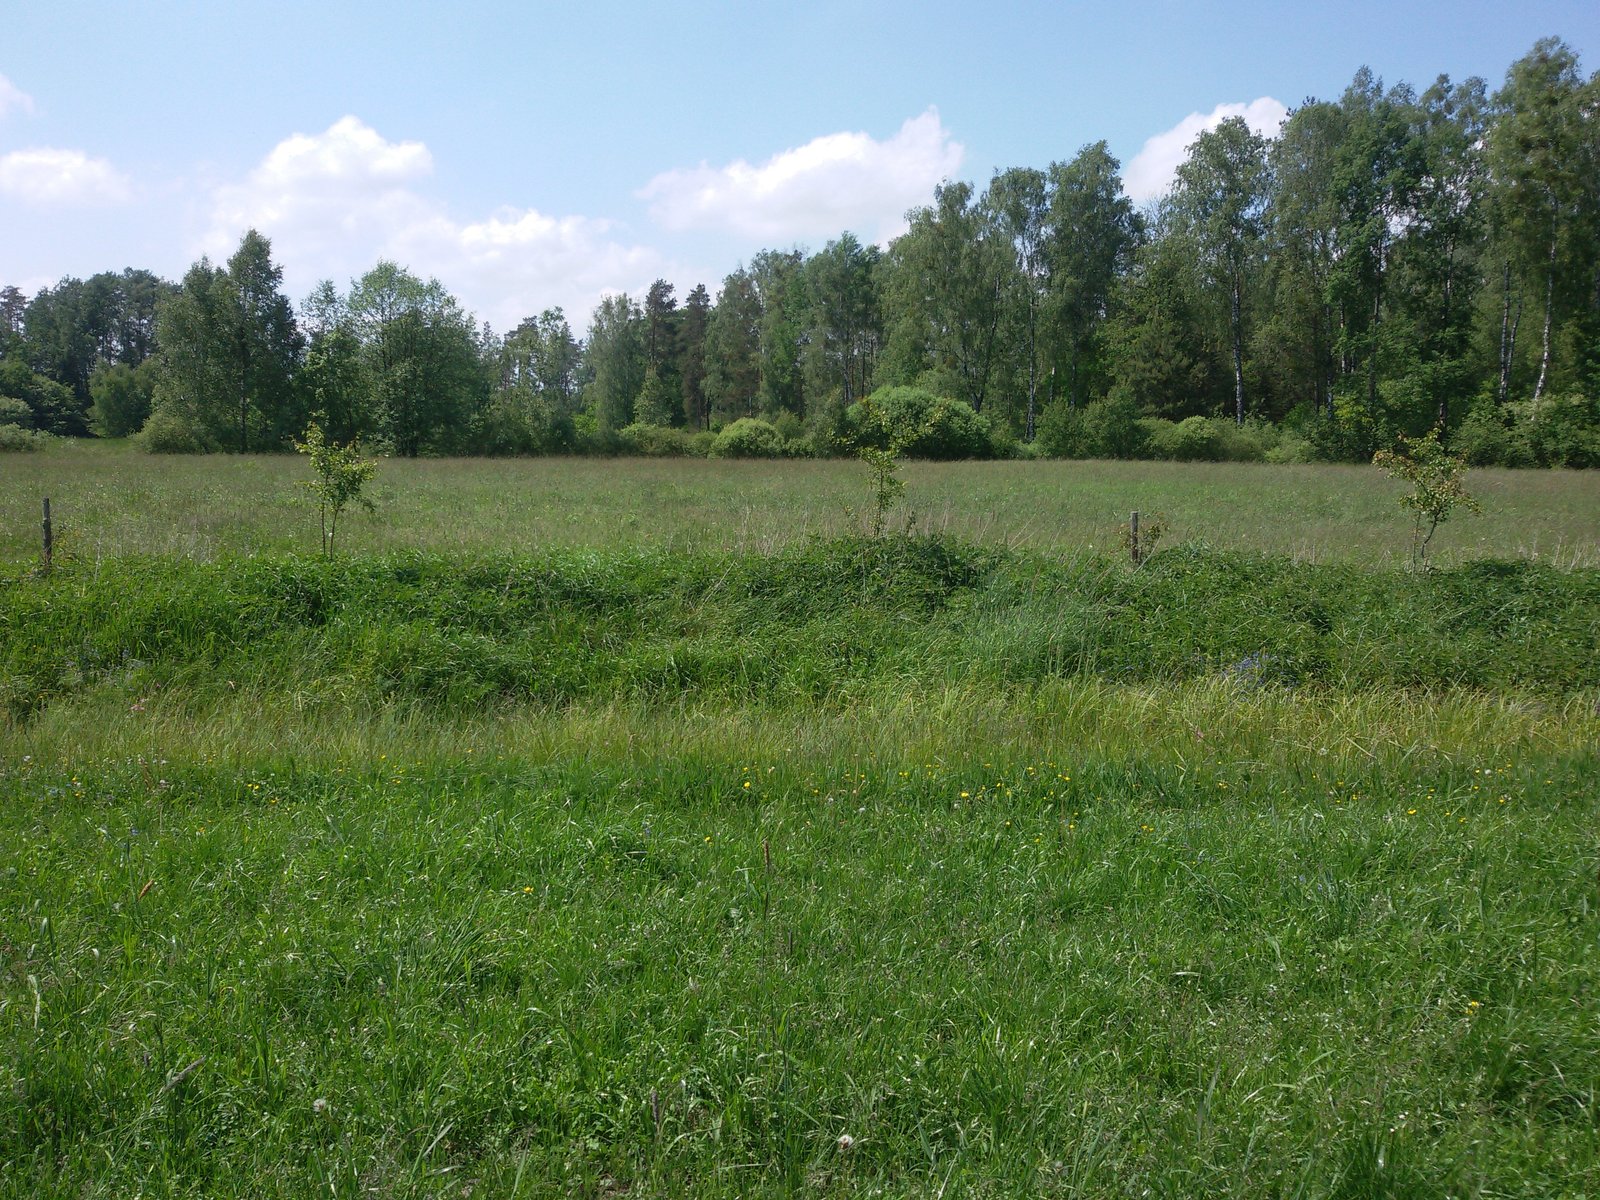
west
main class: Grassland
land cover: Grassland without tree/shrub cover
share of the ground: > 75 %
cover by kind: herbaceous plants 100 %
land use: Agriculture (excluding fallow land and kitchen gardens)
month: June
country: PL
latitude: 53.4506
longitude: 21.5094
